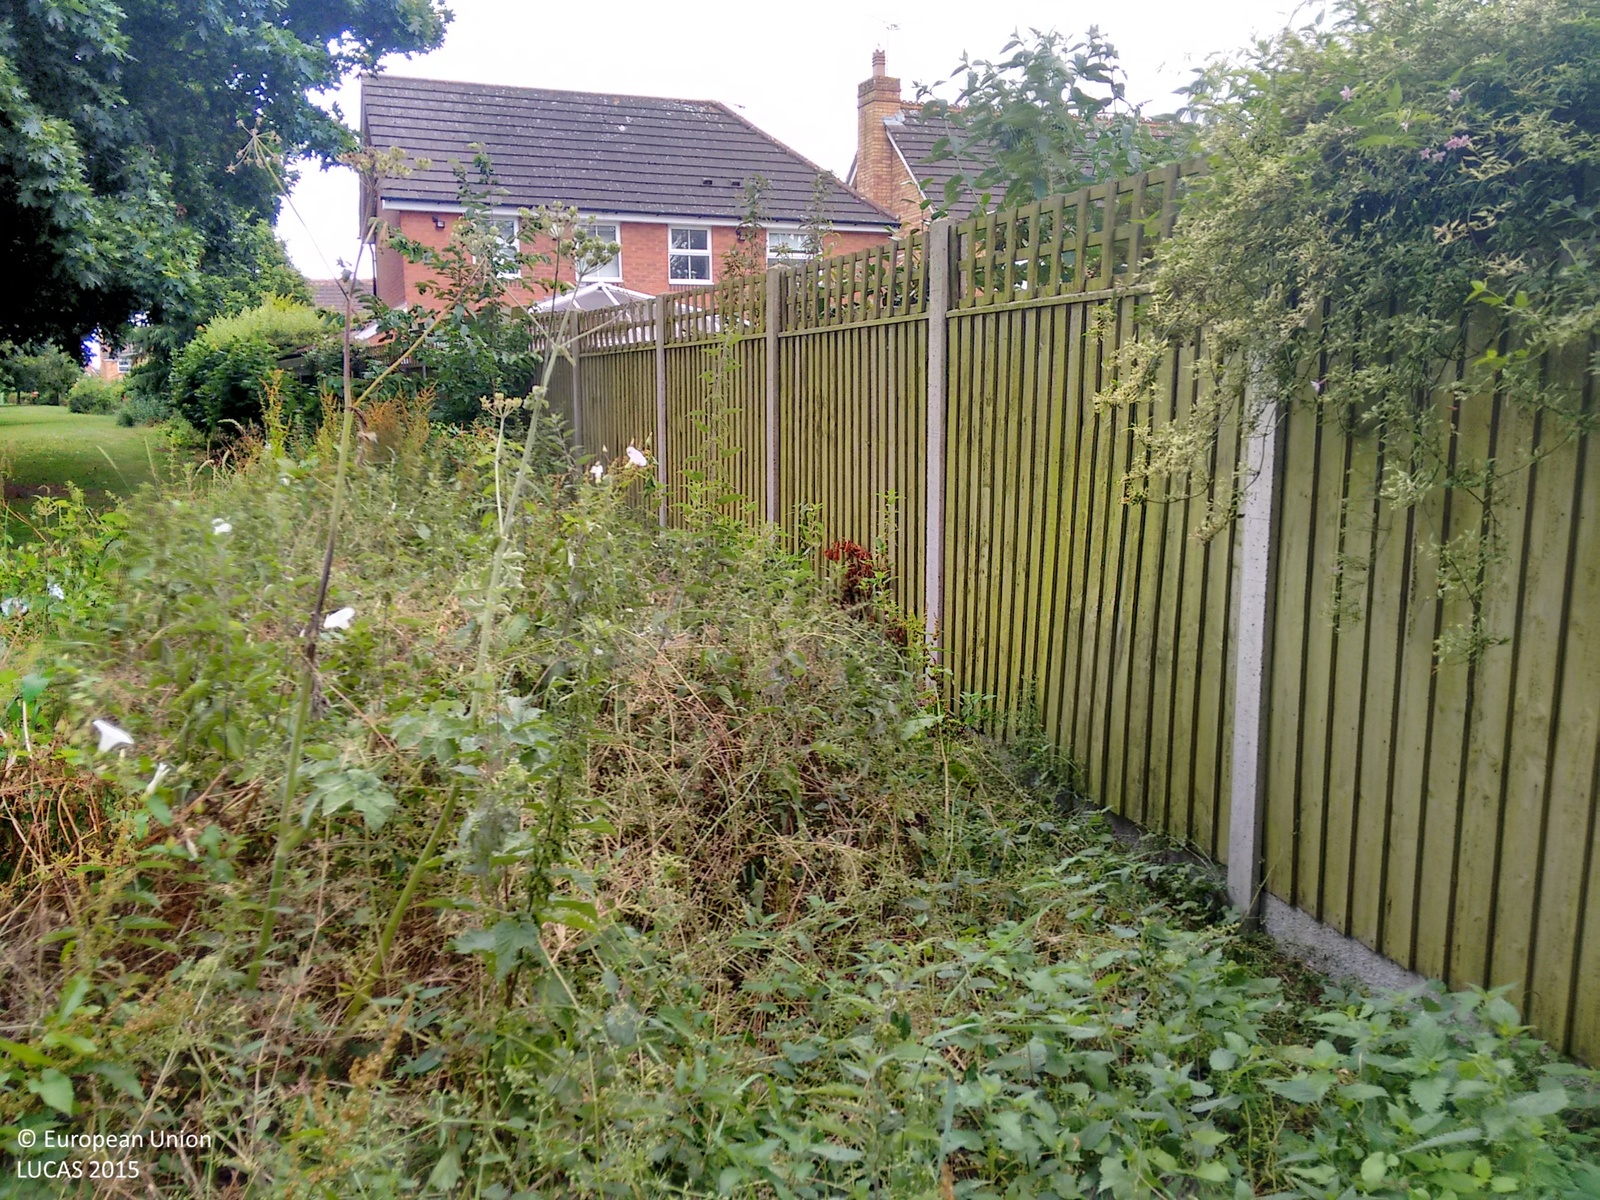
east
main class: Grassland
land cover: Grassland with sparse tree/shrub cover
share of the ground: > 75 %
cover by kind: herbaceous plants 90 %, broadleaved forest trees 5 %, shrubs 5 %
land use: Amenities, museums, leisure
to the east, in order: Grassland with sparse tree/shrub cover; Artificial constructions in urban areas
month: July
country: GB
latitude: 52.4034
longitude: -1.4415
